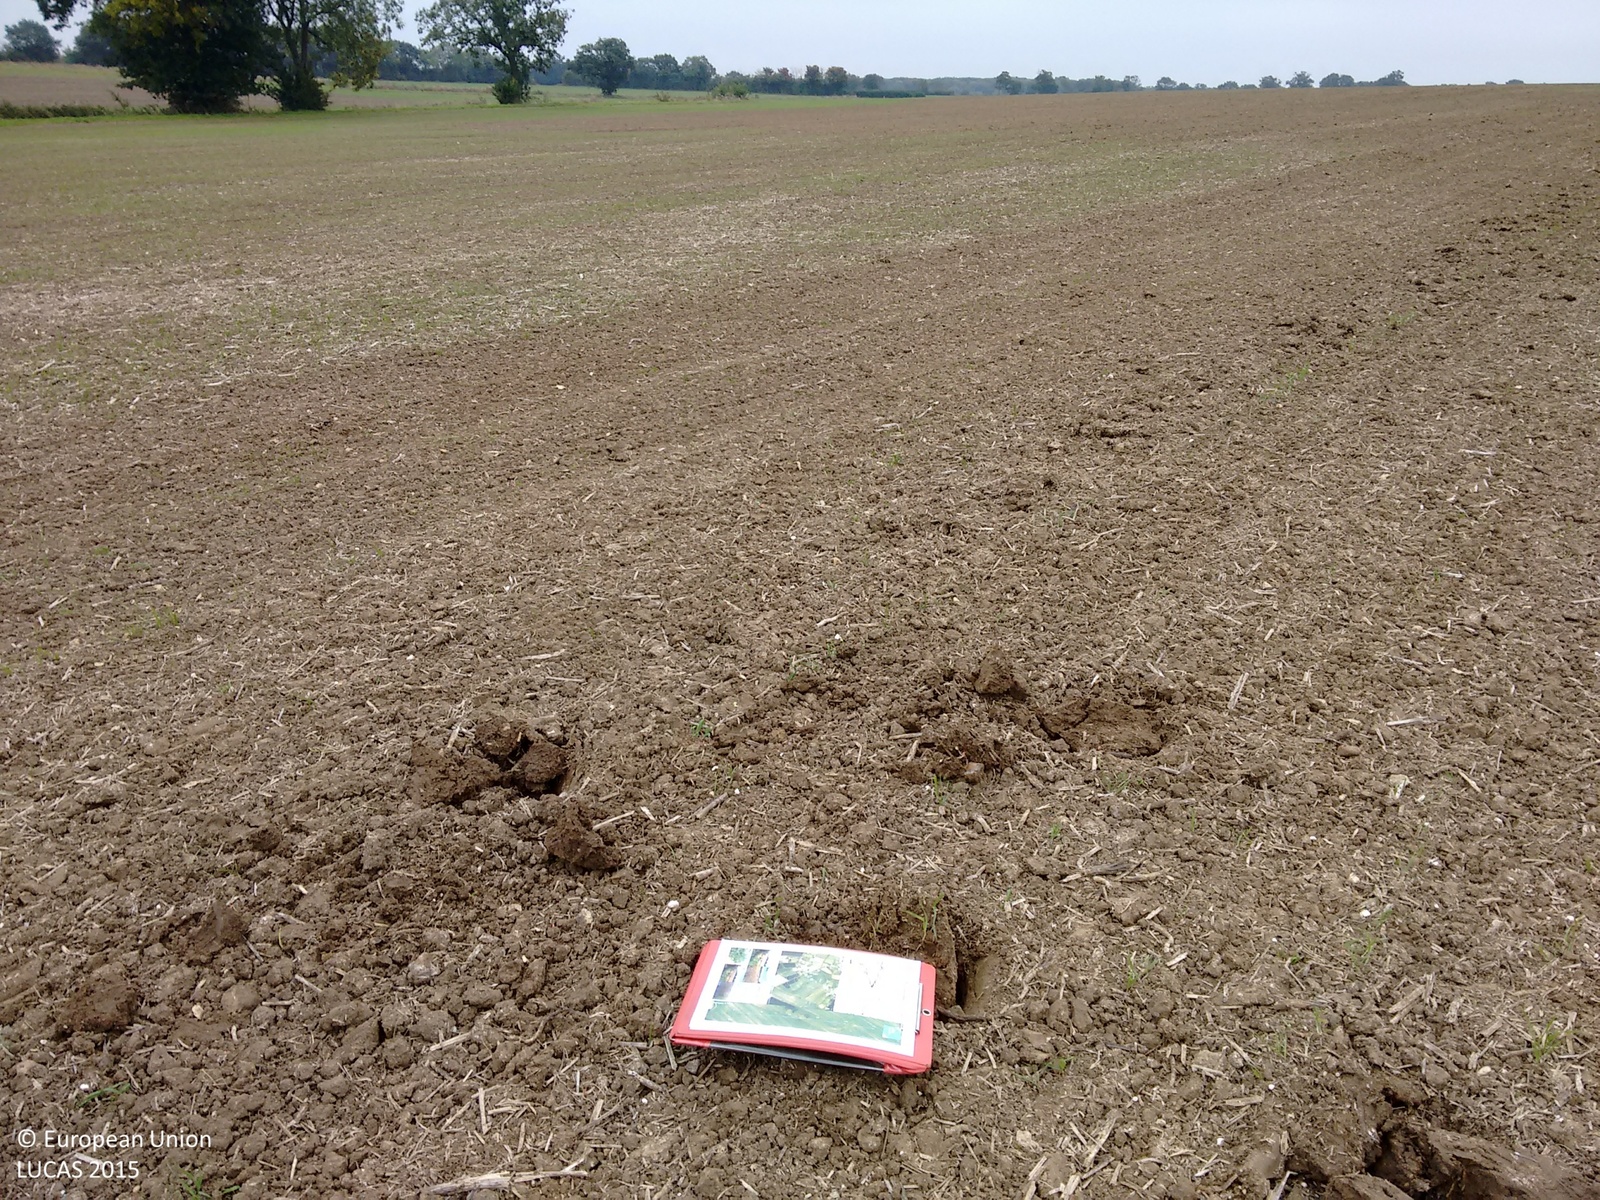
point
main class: Cropland
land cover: Common wheat
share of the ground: < 10 %
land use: Agriculture (excluding fallow land and kitchen gardens)
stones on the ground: 10 - 25 %
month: October
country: GB
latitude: 52.3210
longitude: 0.9537
